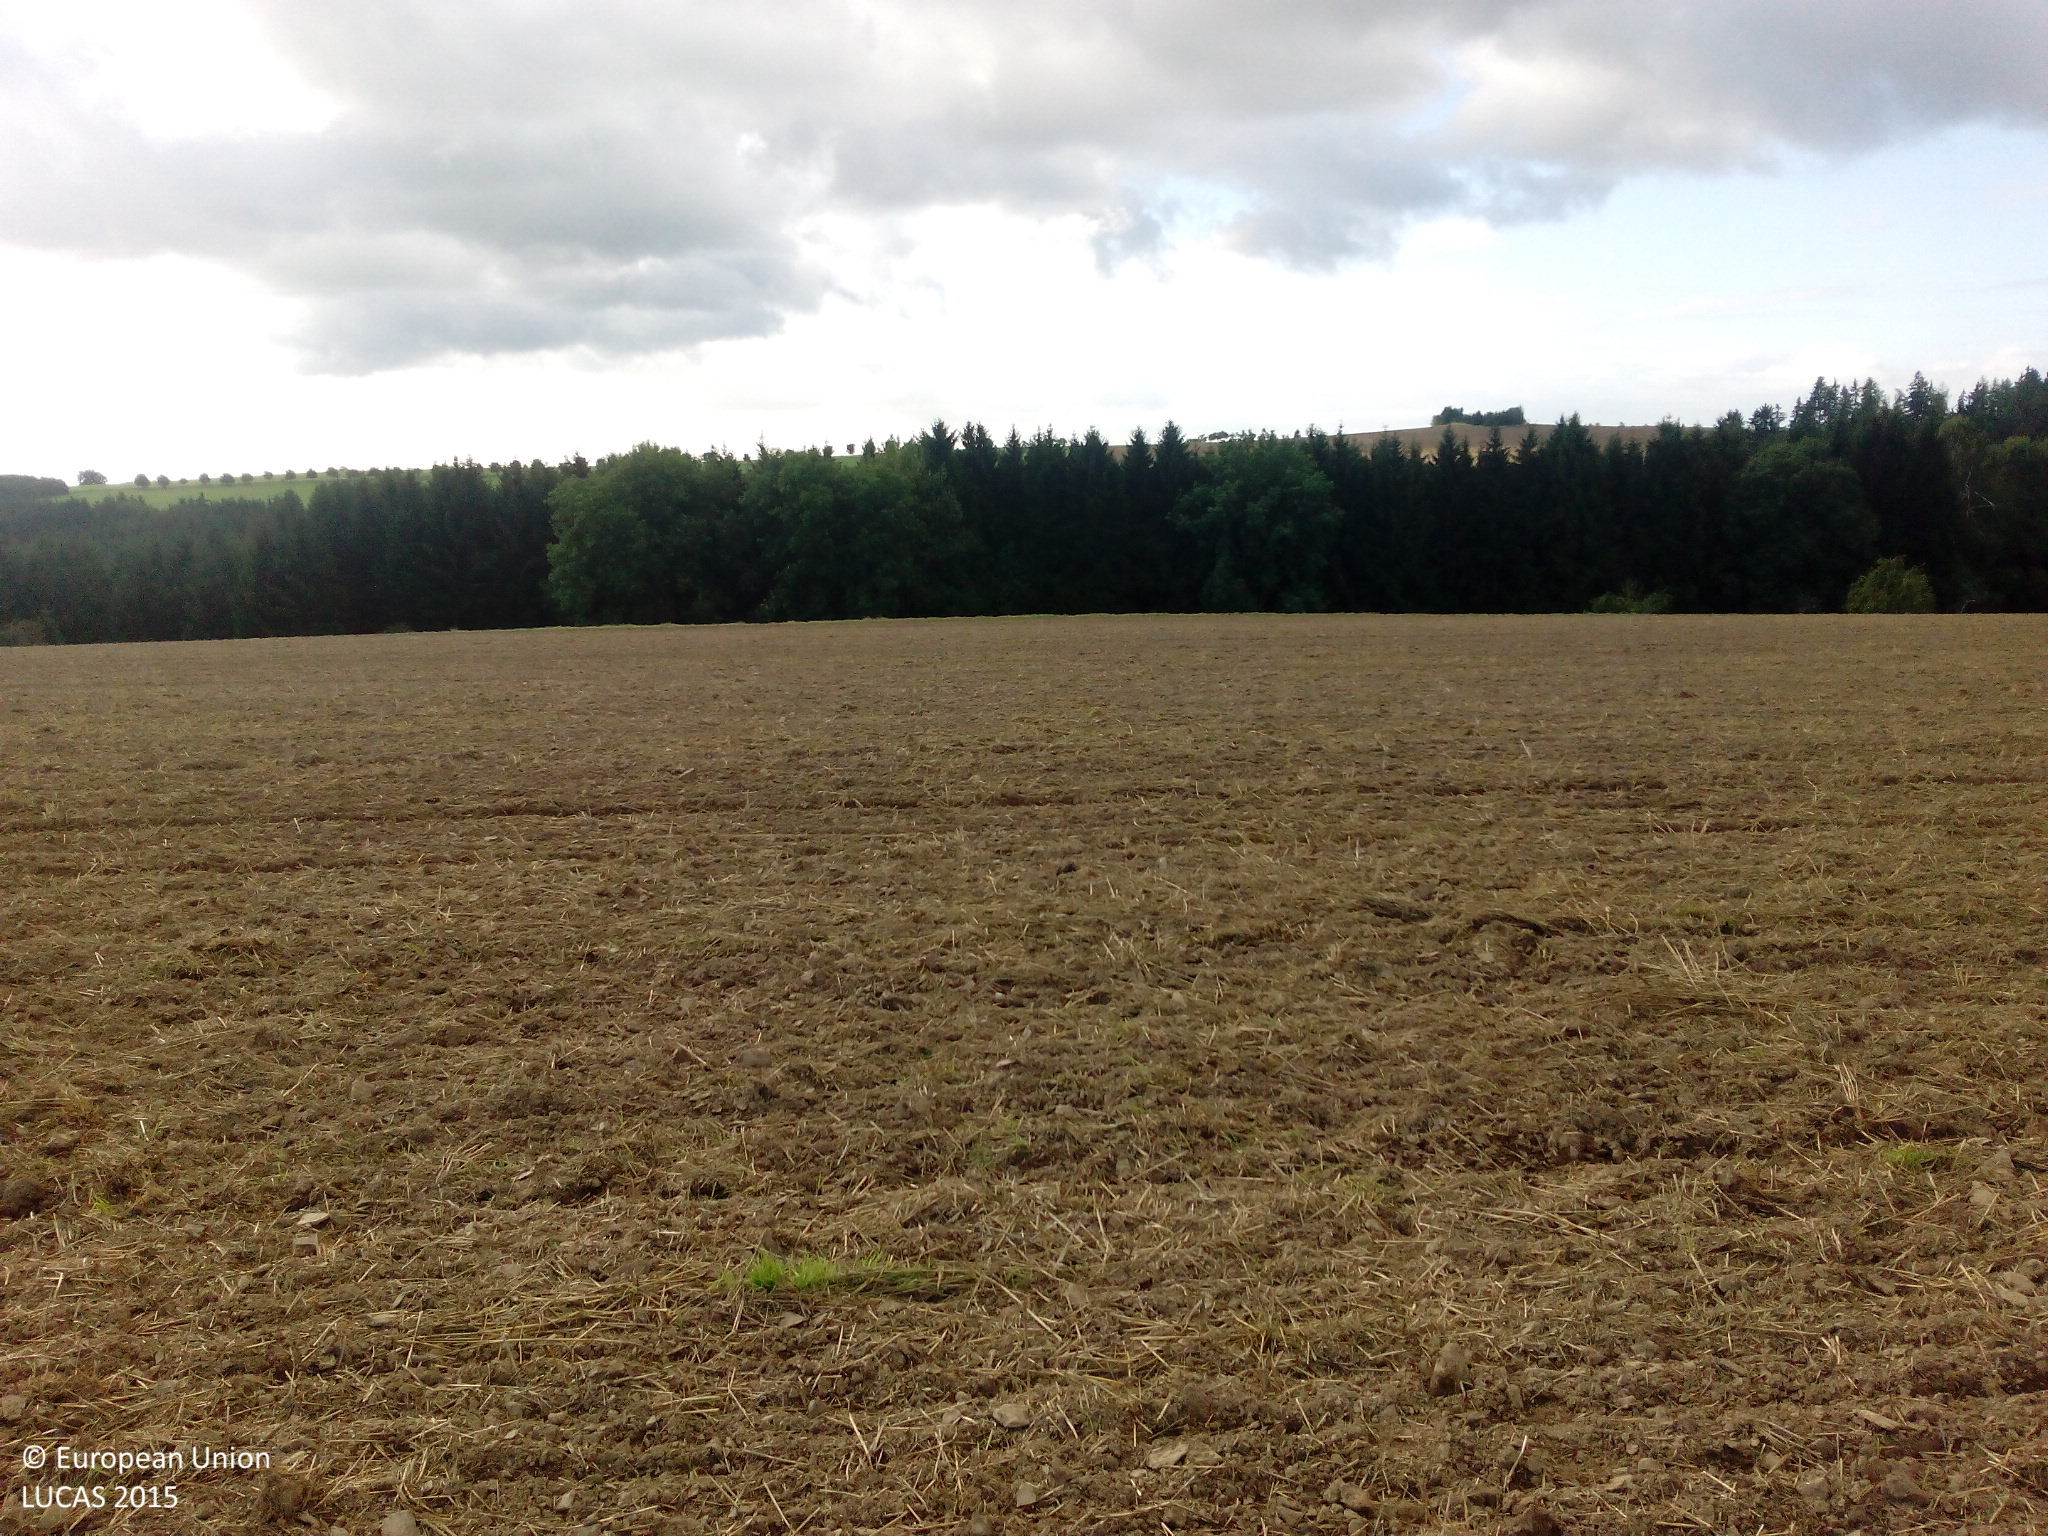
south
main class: Cropland
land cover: Common wheat
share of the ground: < 10 %
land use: Agriculture (excluding fallow land and kitchen gardens)
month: September
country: DE
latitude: 51.5816
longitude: 11.0820
